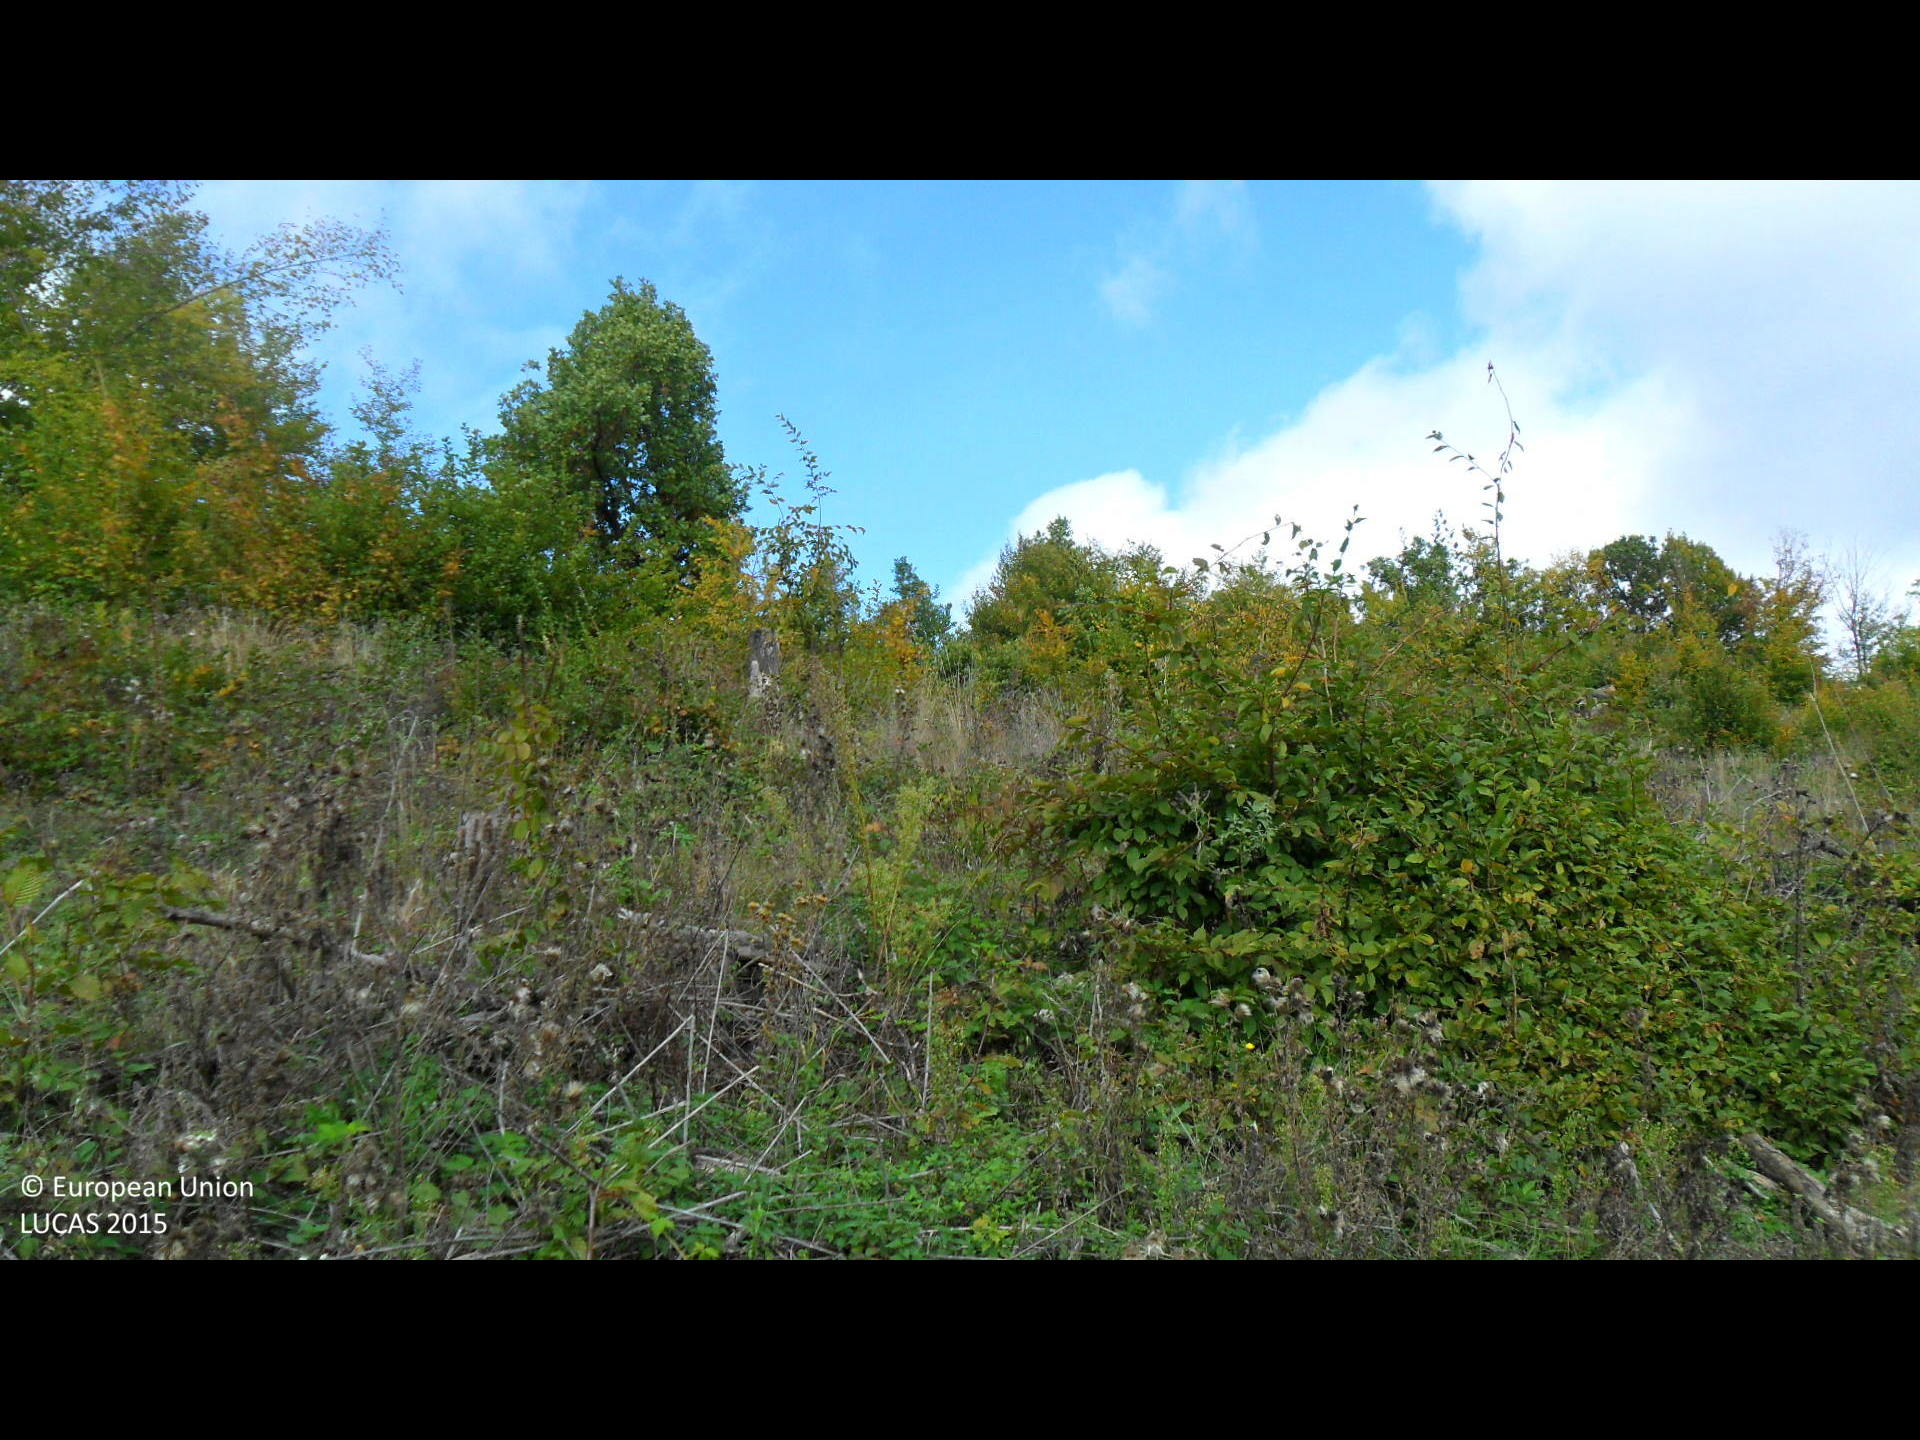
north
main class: Grassland
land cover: Grassland with sparse tree/shrub cover
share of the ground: > 75 %
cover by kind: herbaceous plants 90 %, broadleaved forest trees 5 %, shrubs 5 %
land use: Agriculture (excluding fallow land and kitchen gardens)
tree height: < 5 m
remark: Clear cut
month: October
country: BG
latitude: 43.0374
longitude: 26.1578
